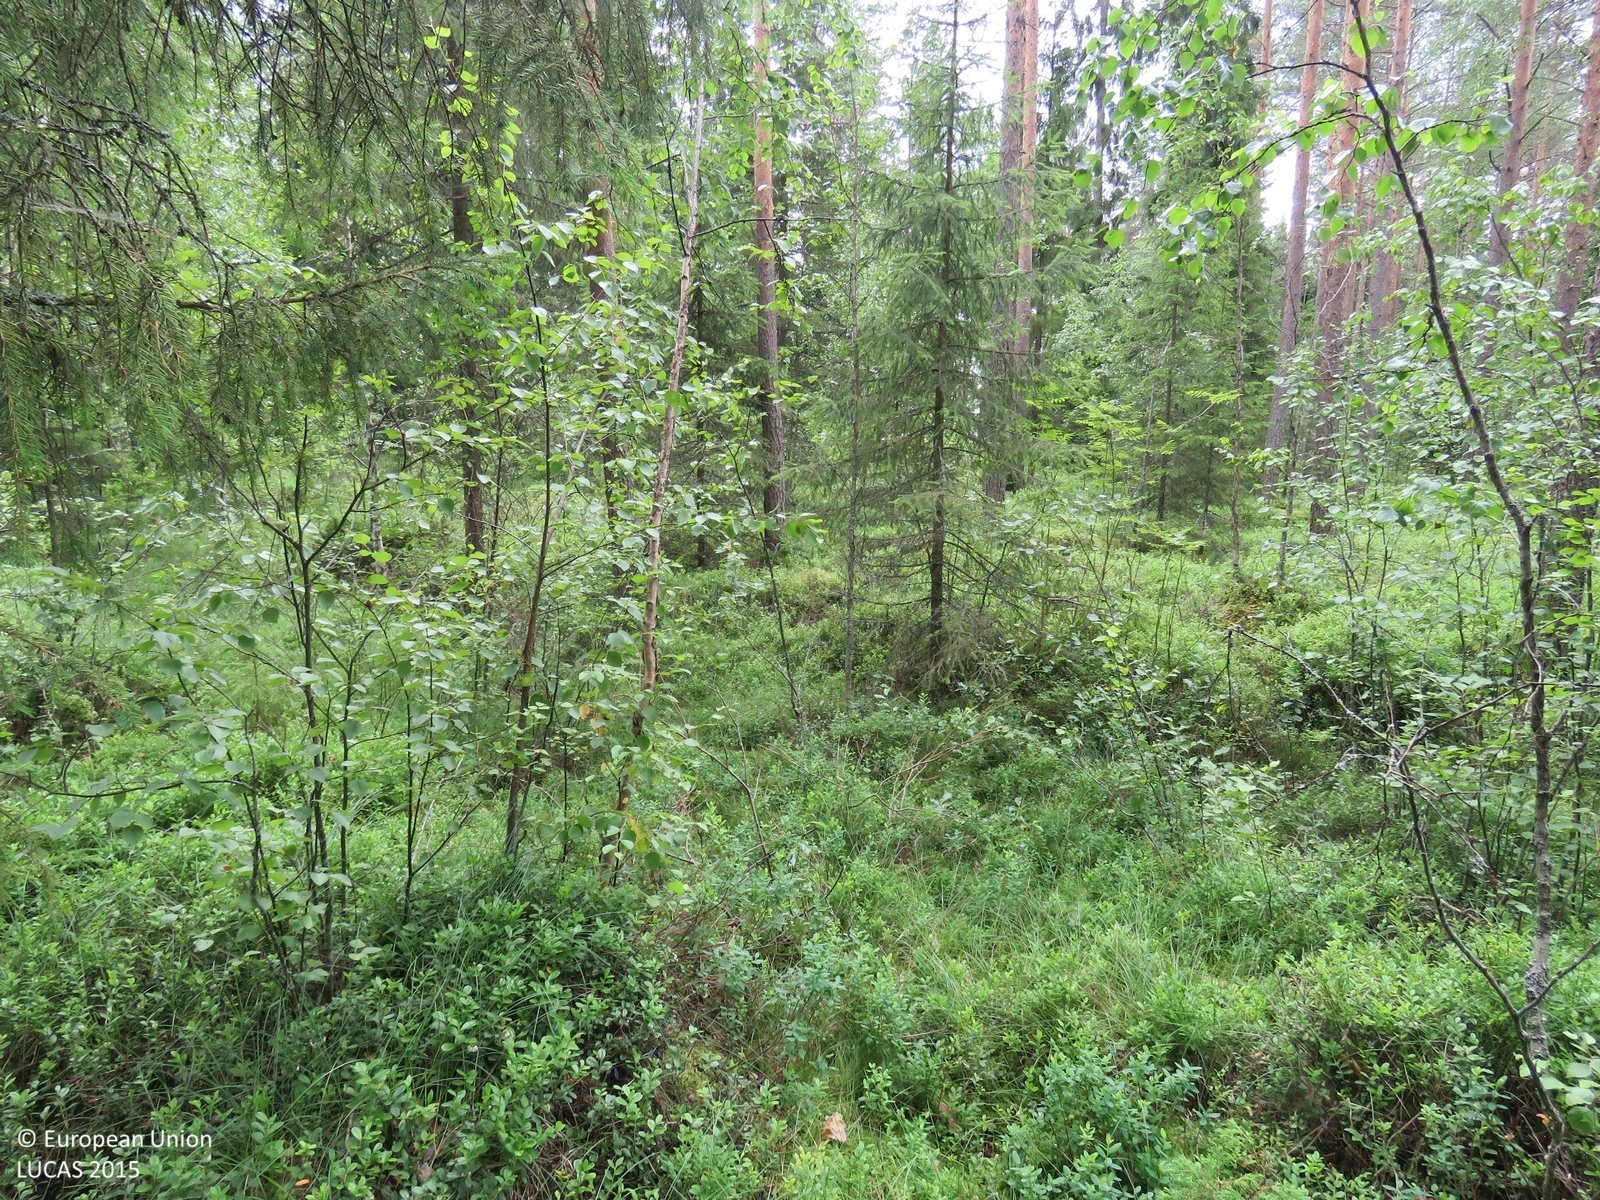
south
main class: Woodland
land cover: Spruce dominated coniferous woodland
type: boreal forest
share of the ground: > 75 %
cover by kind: coniferous forest trees 75 %, shrubs 15 %, broadleaved forest trees 10 %
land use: Forestry
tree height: > 5 m
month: July
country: FI
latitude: 64.4686
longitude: 26.5225
